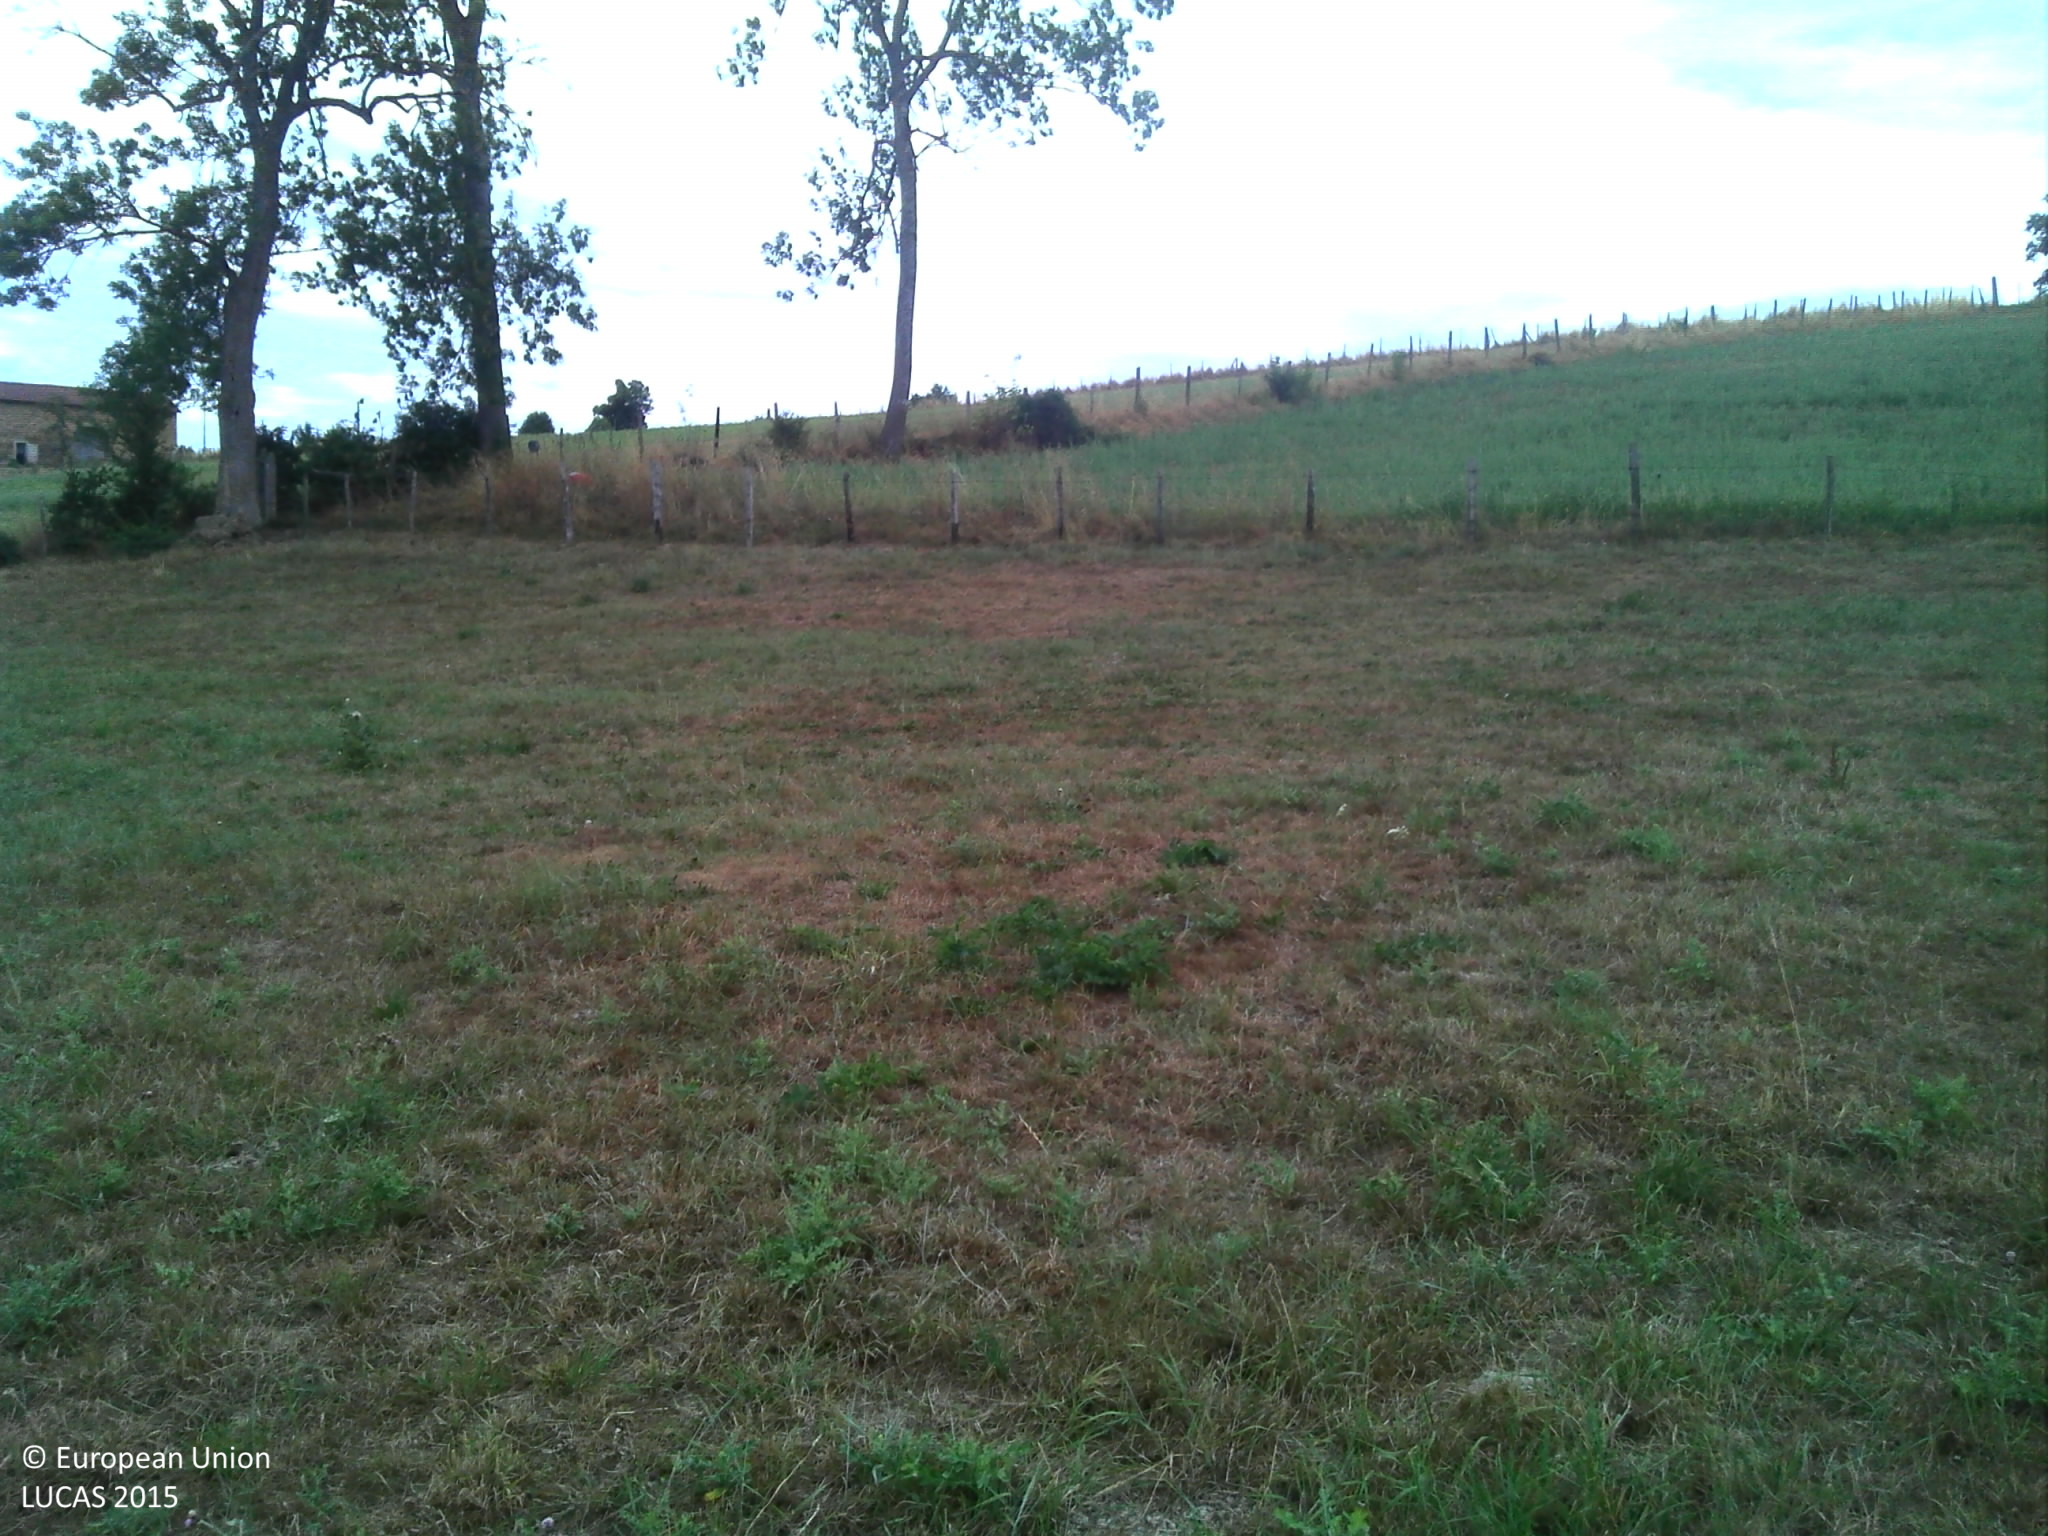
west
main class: Grassland
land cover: Grassland without tree/shrub cover
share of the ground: > 75 %
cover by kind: herbaceous plants 100 %
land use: Agriculture (excluding fallow land and kitchen gardens)
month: July
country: FR
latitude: 45.6486
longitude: 4.4730
